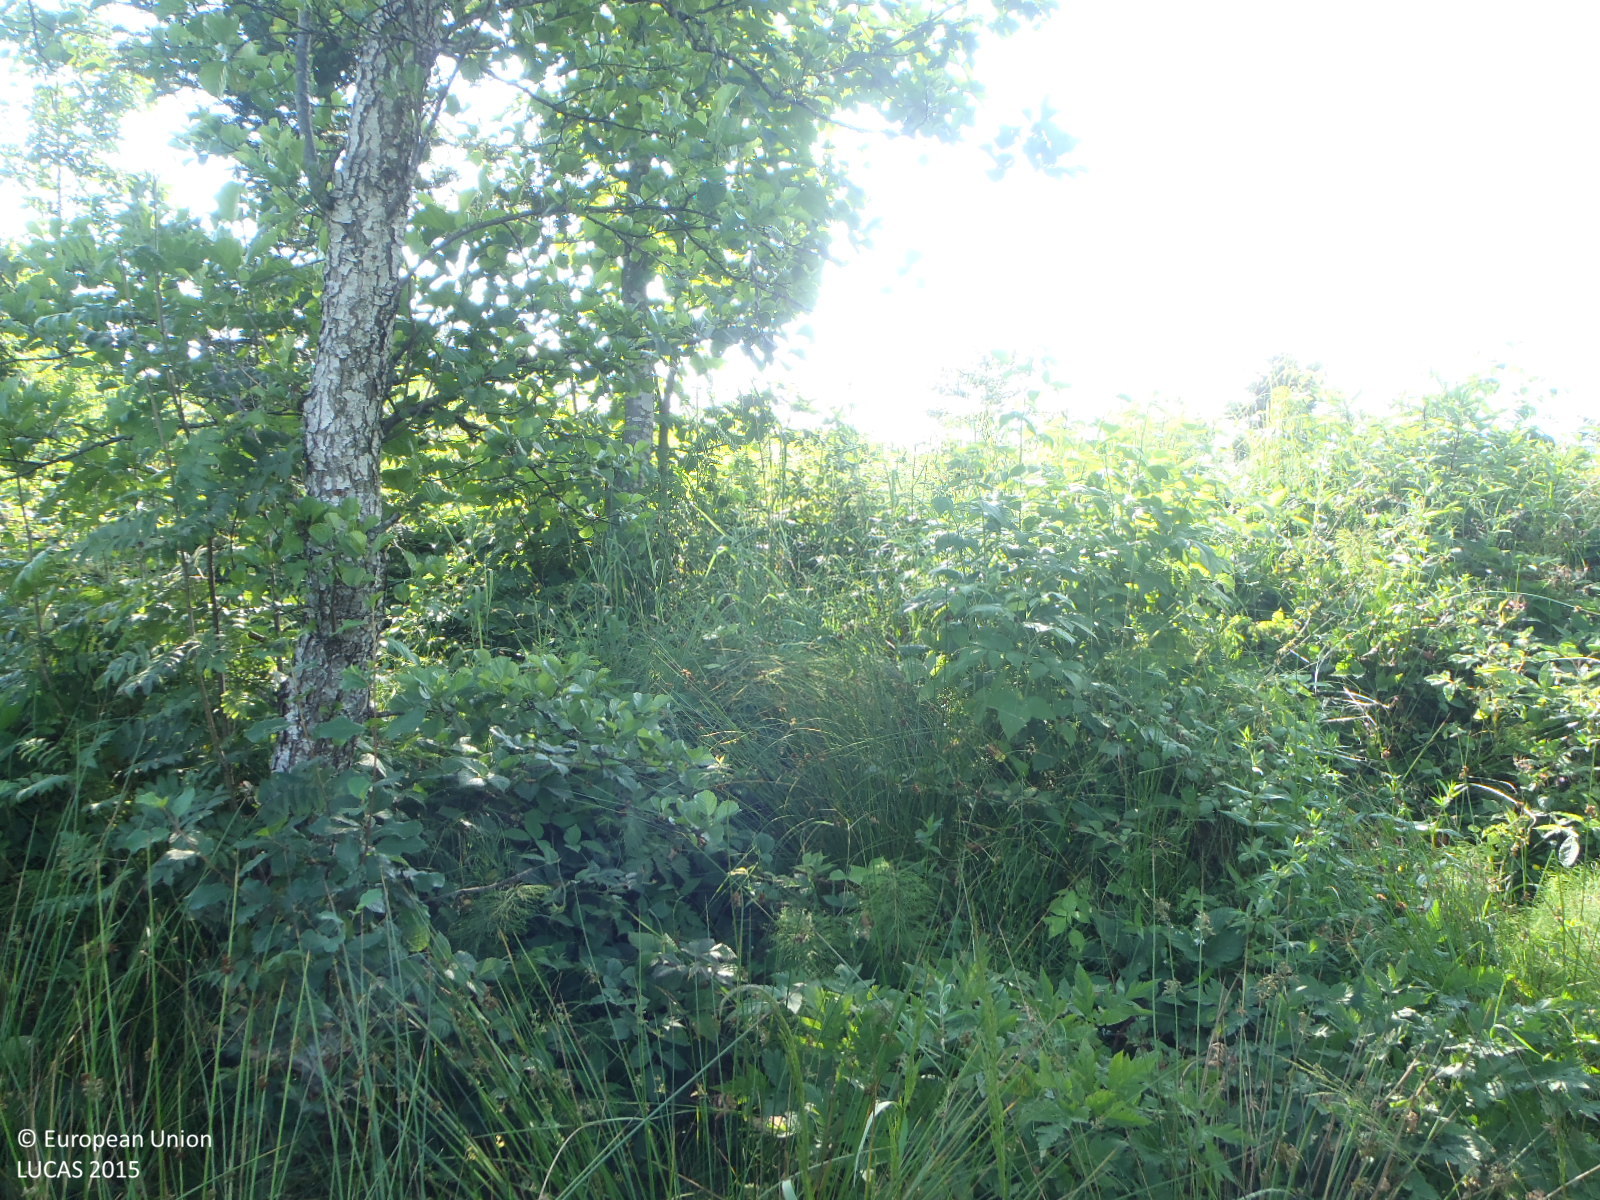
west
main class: Woodland
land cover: Spruce dominated mixed woodland
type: alpine coniferous forest
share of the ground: > 75 %
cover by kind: shrubs 45 %, herbaceous plants 25 %, coniferous forest trees 15 %, broadleaved forest trees 15 %
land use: Forestry
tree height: > 5 m
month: July
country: AT
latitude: 47.5138
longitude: 12.3752
